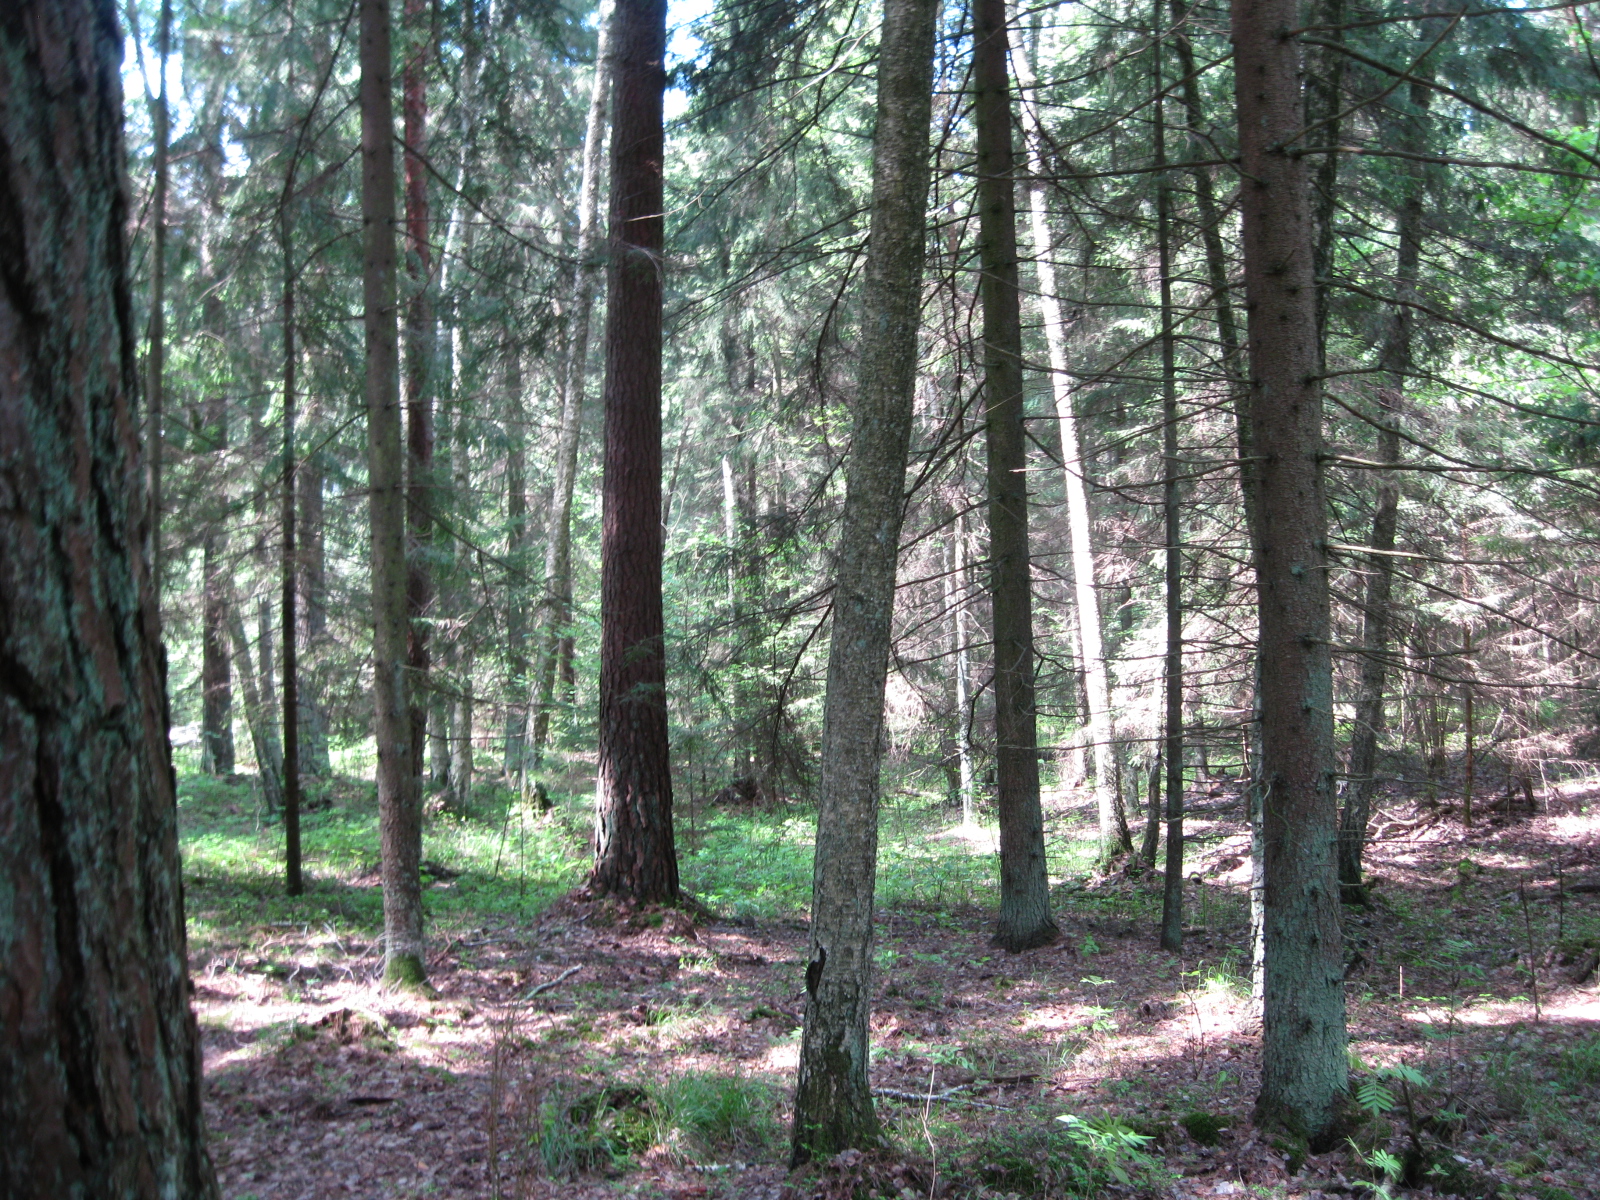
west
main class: Woodland
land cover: Spruce dominated mixed woodland
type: hemiboreal forest and nemoral coniferous forest and mixed broadleaved-coniferous forest
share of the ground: > 75 %
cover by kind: coniferous forest trees 50 %, broadleaved forest trees 45 %, lichens and mosses 5 %
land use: Forestry
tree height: > 5 m
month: May
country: LT
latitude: 56.0047
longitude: 24.1219
